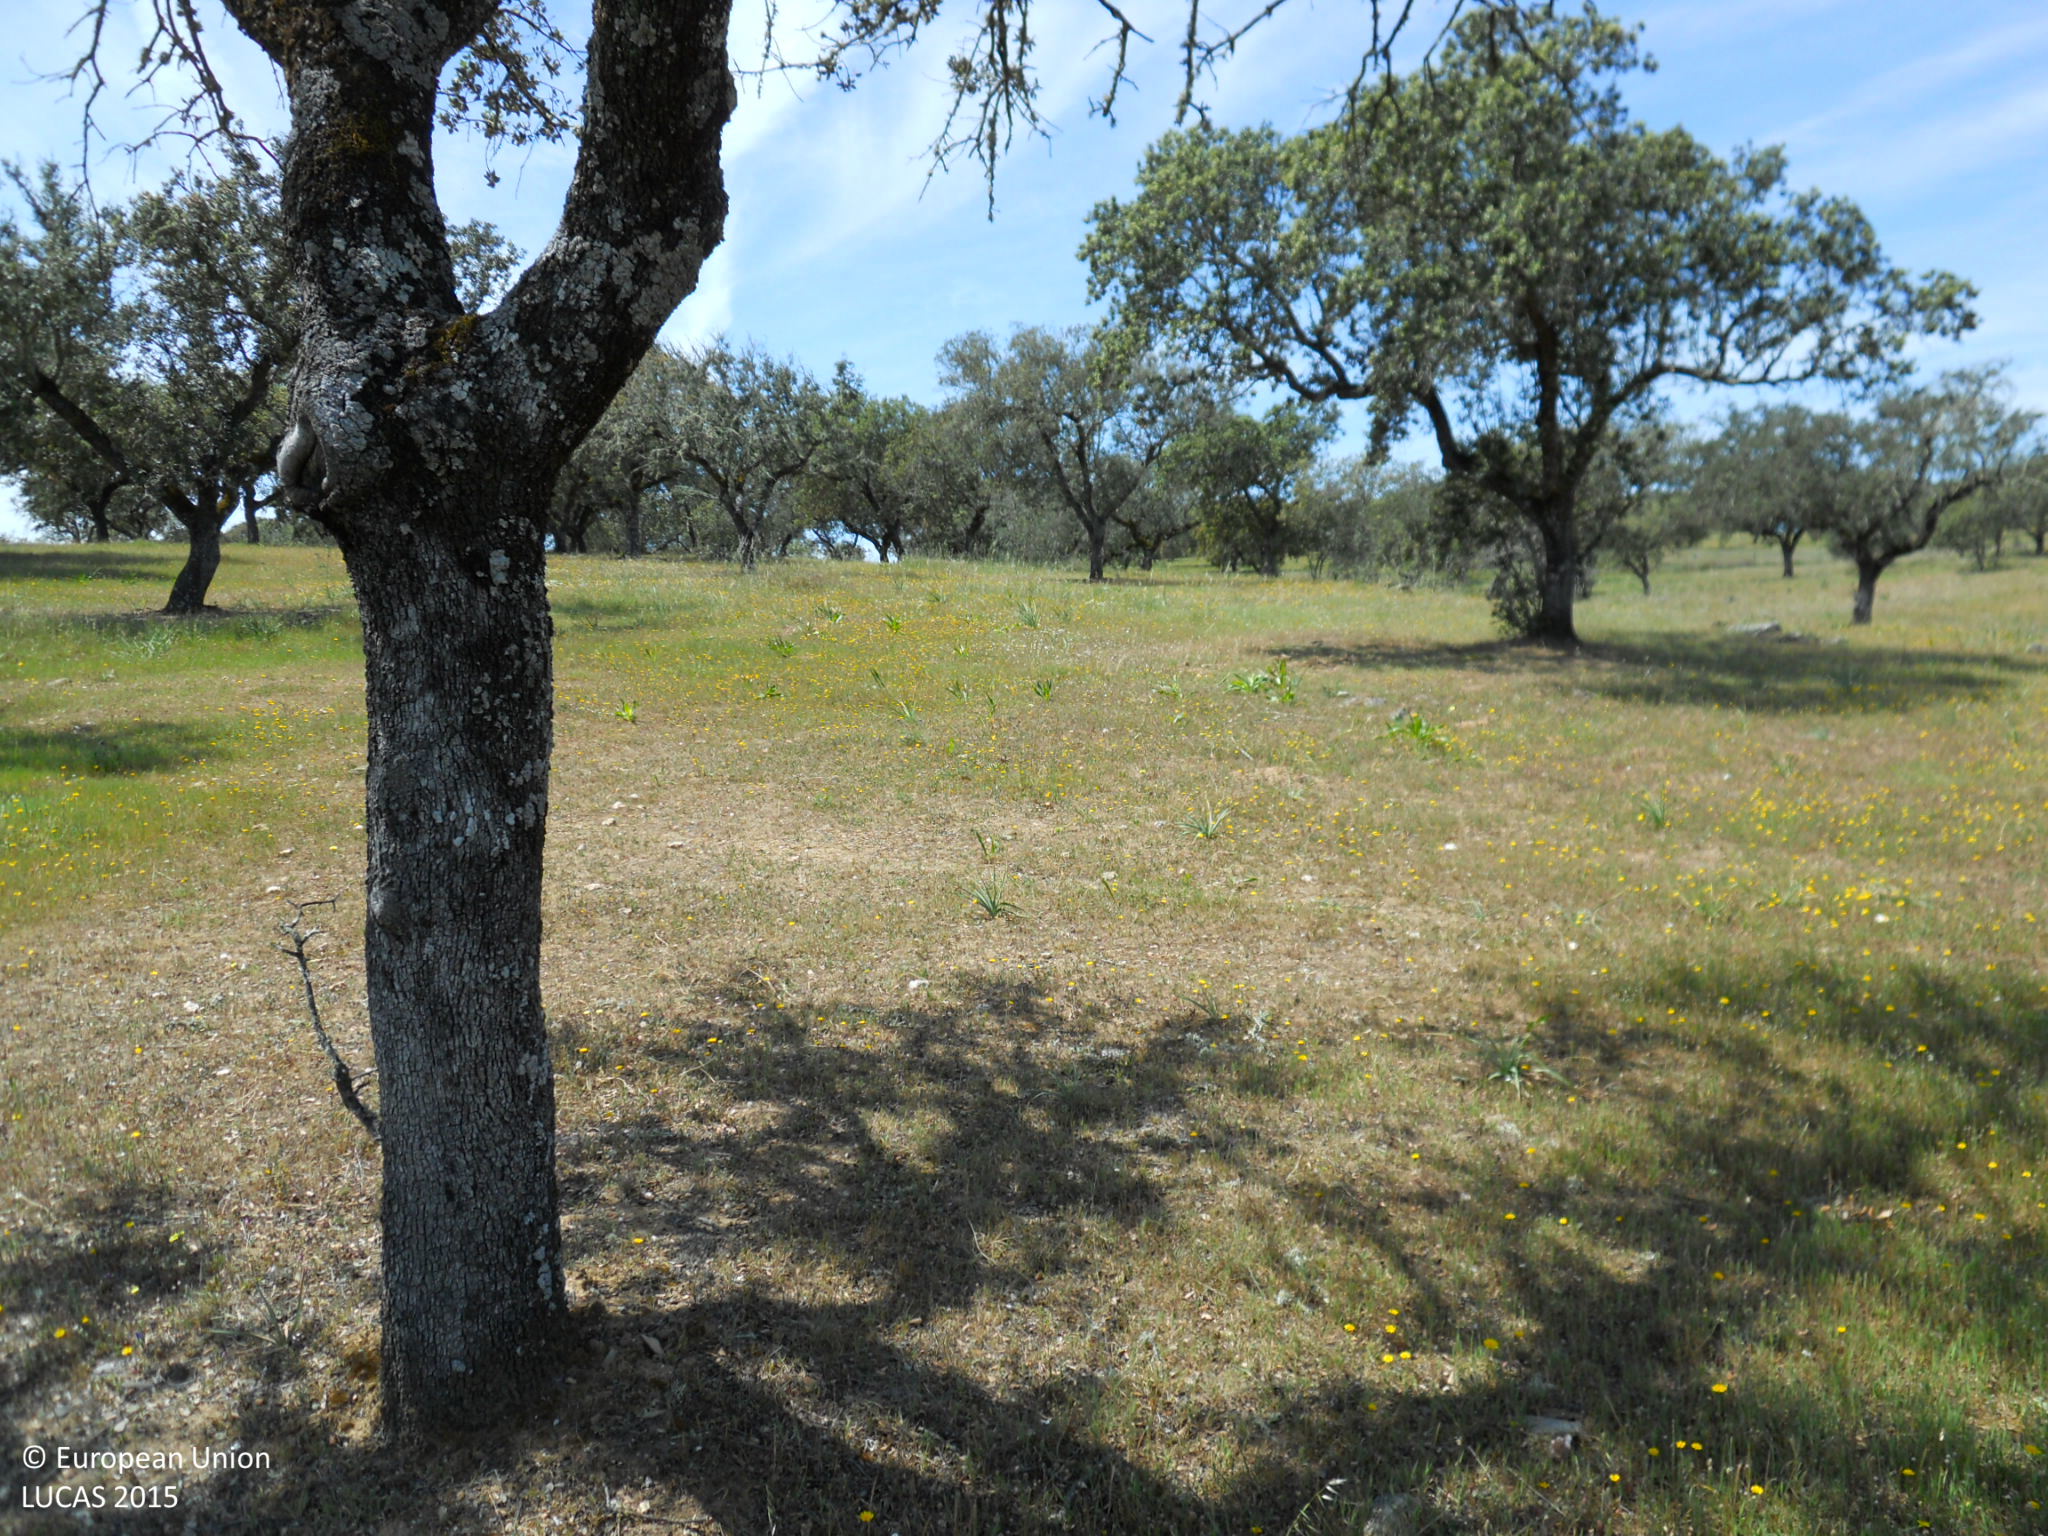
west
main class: Woodland
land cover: Broadleaved woodland
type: broadleaved evergreen forest
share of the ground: 10 - 25 %
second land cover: Grassland without tree/shrub cover
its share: > 75 %
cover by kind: herbaceous plants 70 %, broadleaved forest trees 20 %, unconsolidated bare surface 10 %
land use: Forestry
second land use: Agriculture (excluding fallow land and kitchen gardens)
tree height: > 5 m
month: April
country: ES
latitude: 39.3634
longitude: -6.9894
